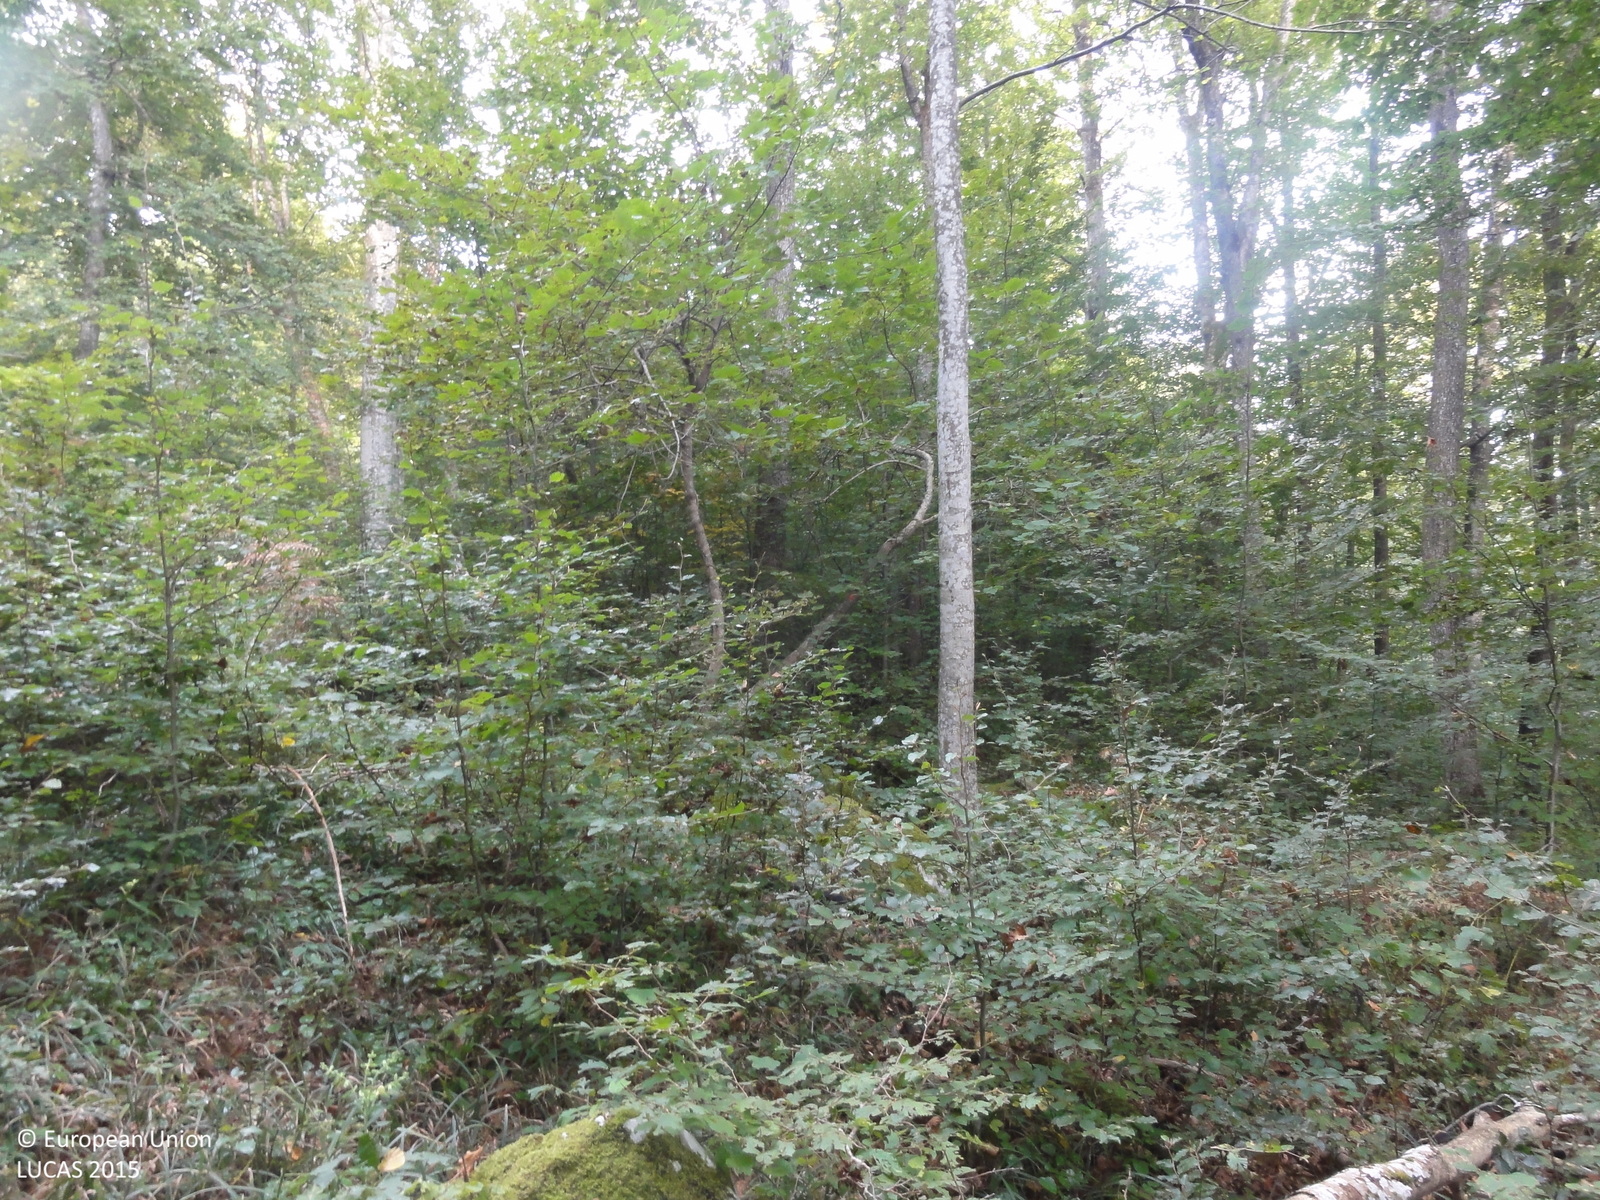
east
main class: Woodland
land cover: Broadleaved woodland
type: beech forest
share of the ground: > 75 %
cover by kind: broadleaved forest trees 90 %, shrubs 10 %
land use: Forestry
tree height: > 5 m
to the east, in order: Broadleaved woodland; Tracks; Broadleaved woodland; Spruce dominated mixed woodland; Spontaneously vegetated surfaces; Sand; Tracks; Spruce dominated mixed woodland
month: September
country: SI
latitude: 45.5662
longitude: 15.0056
